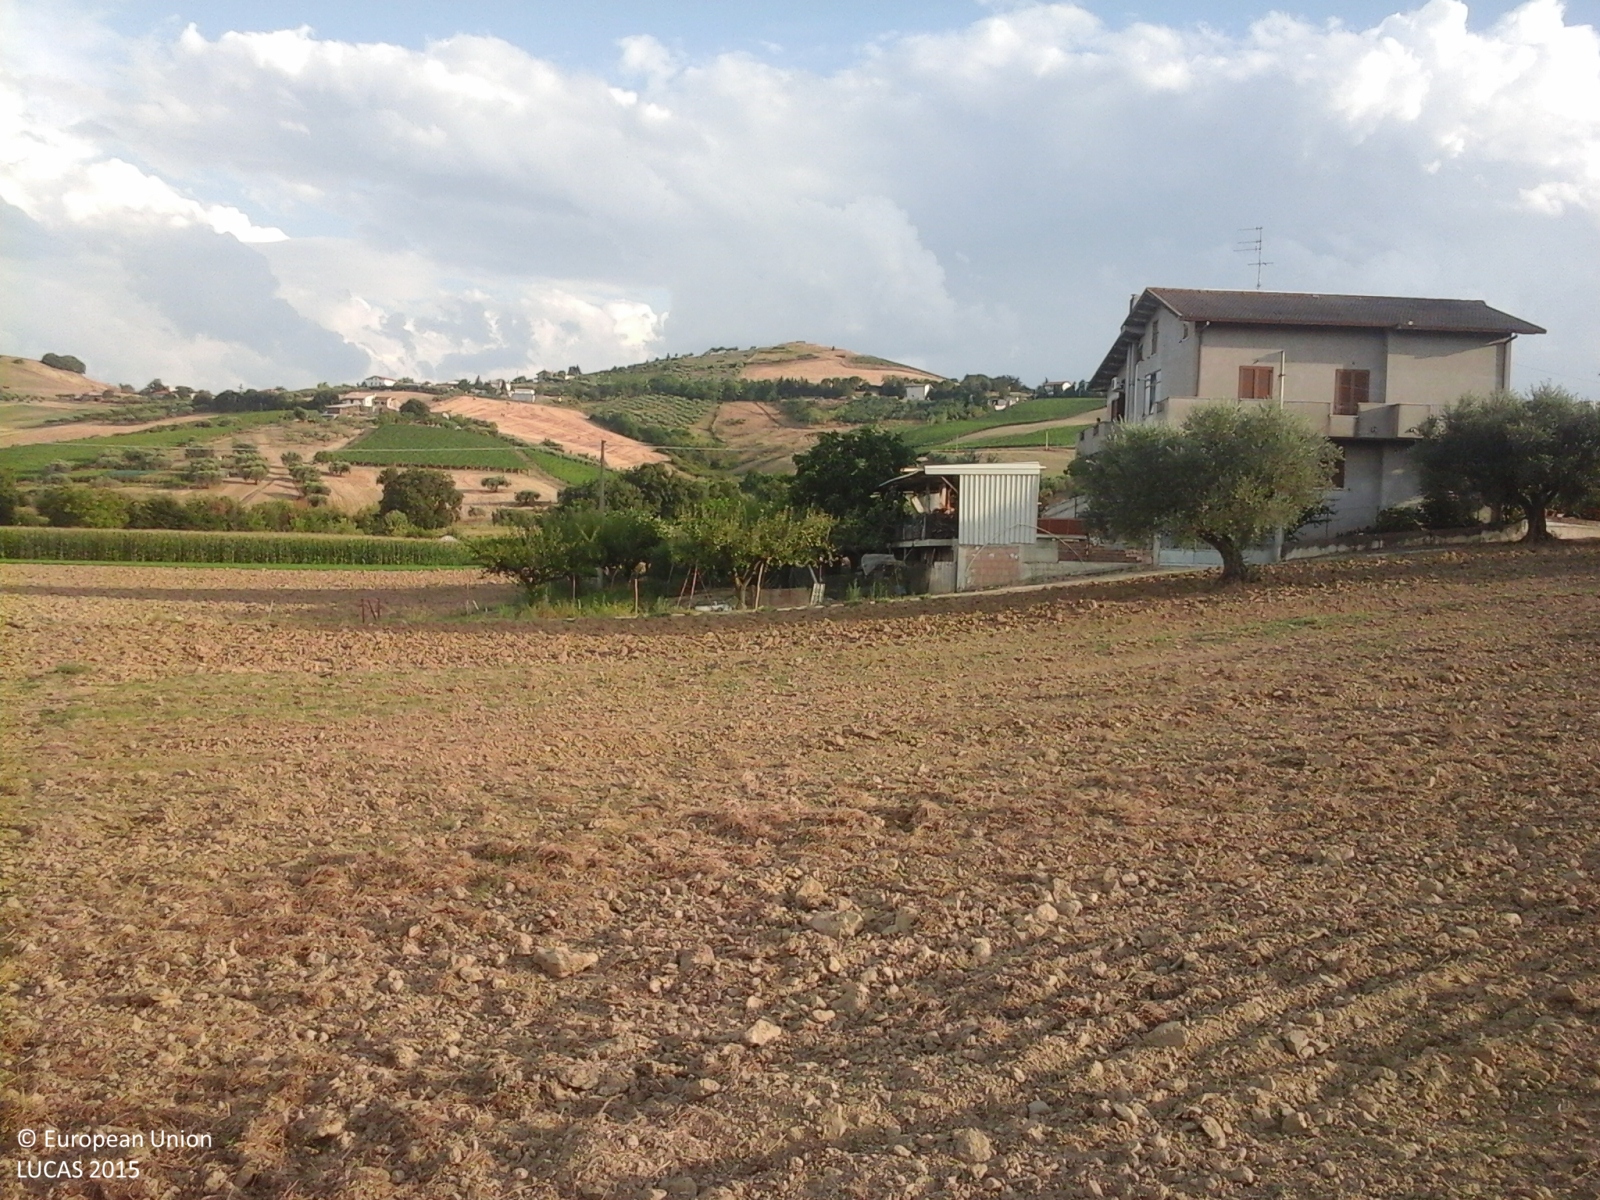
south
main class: Grassland
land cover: Spontaneously vegetated surfaces
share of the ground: > 75 %
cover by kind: herbaceous plants 80 %, unconsolidated bare surface 20 %
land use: Agriculture (excluding fallow land and kitchen gardens)
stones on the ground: < 10 %
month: August
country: IT
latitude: 42.4831
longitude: 14.0390
